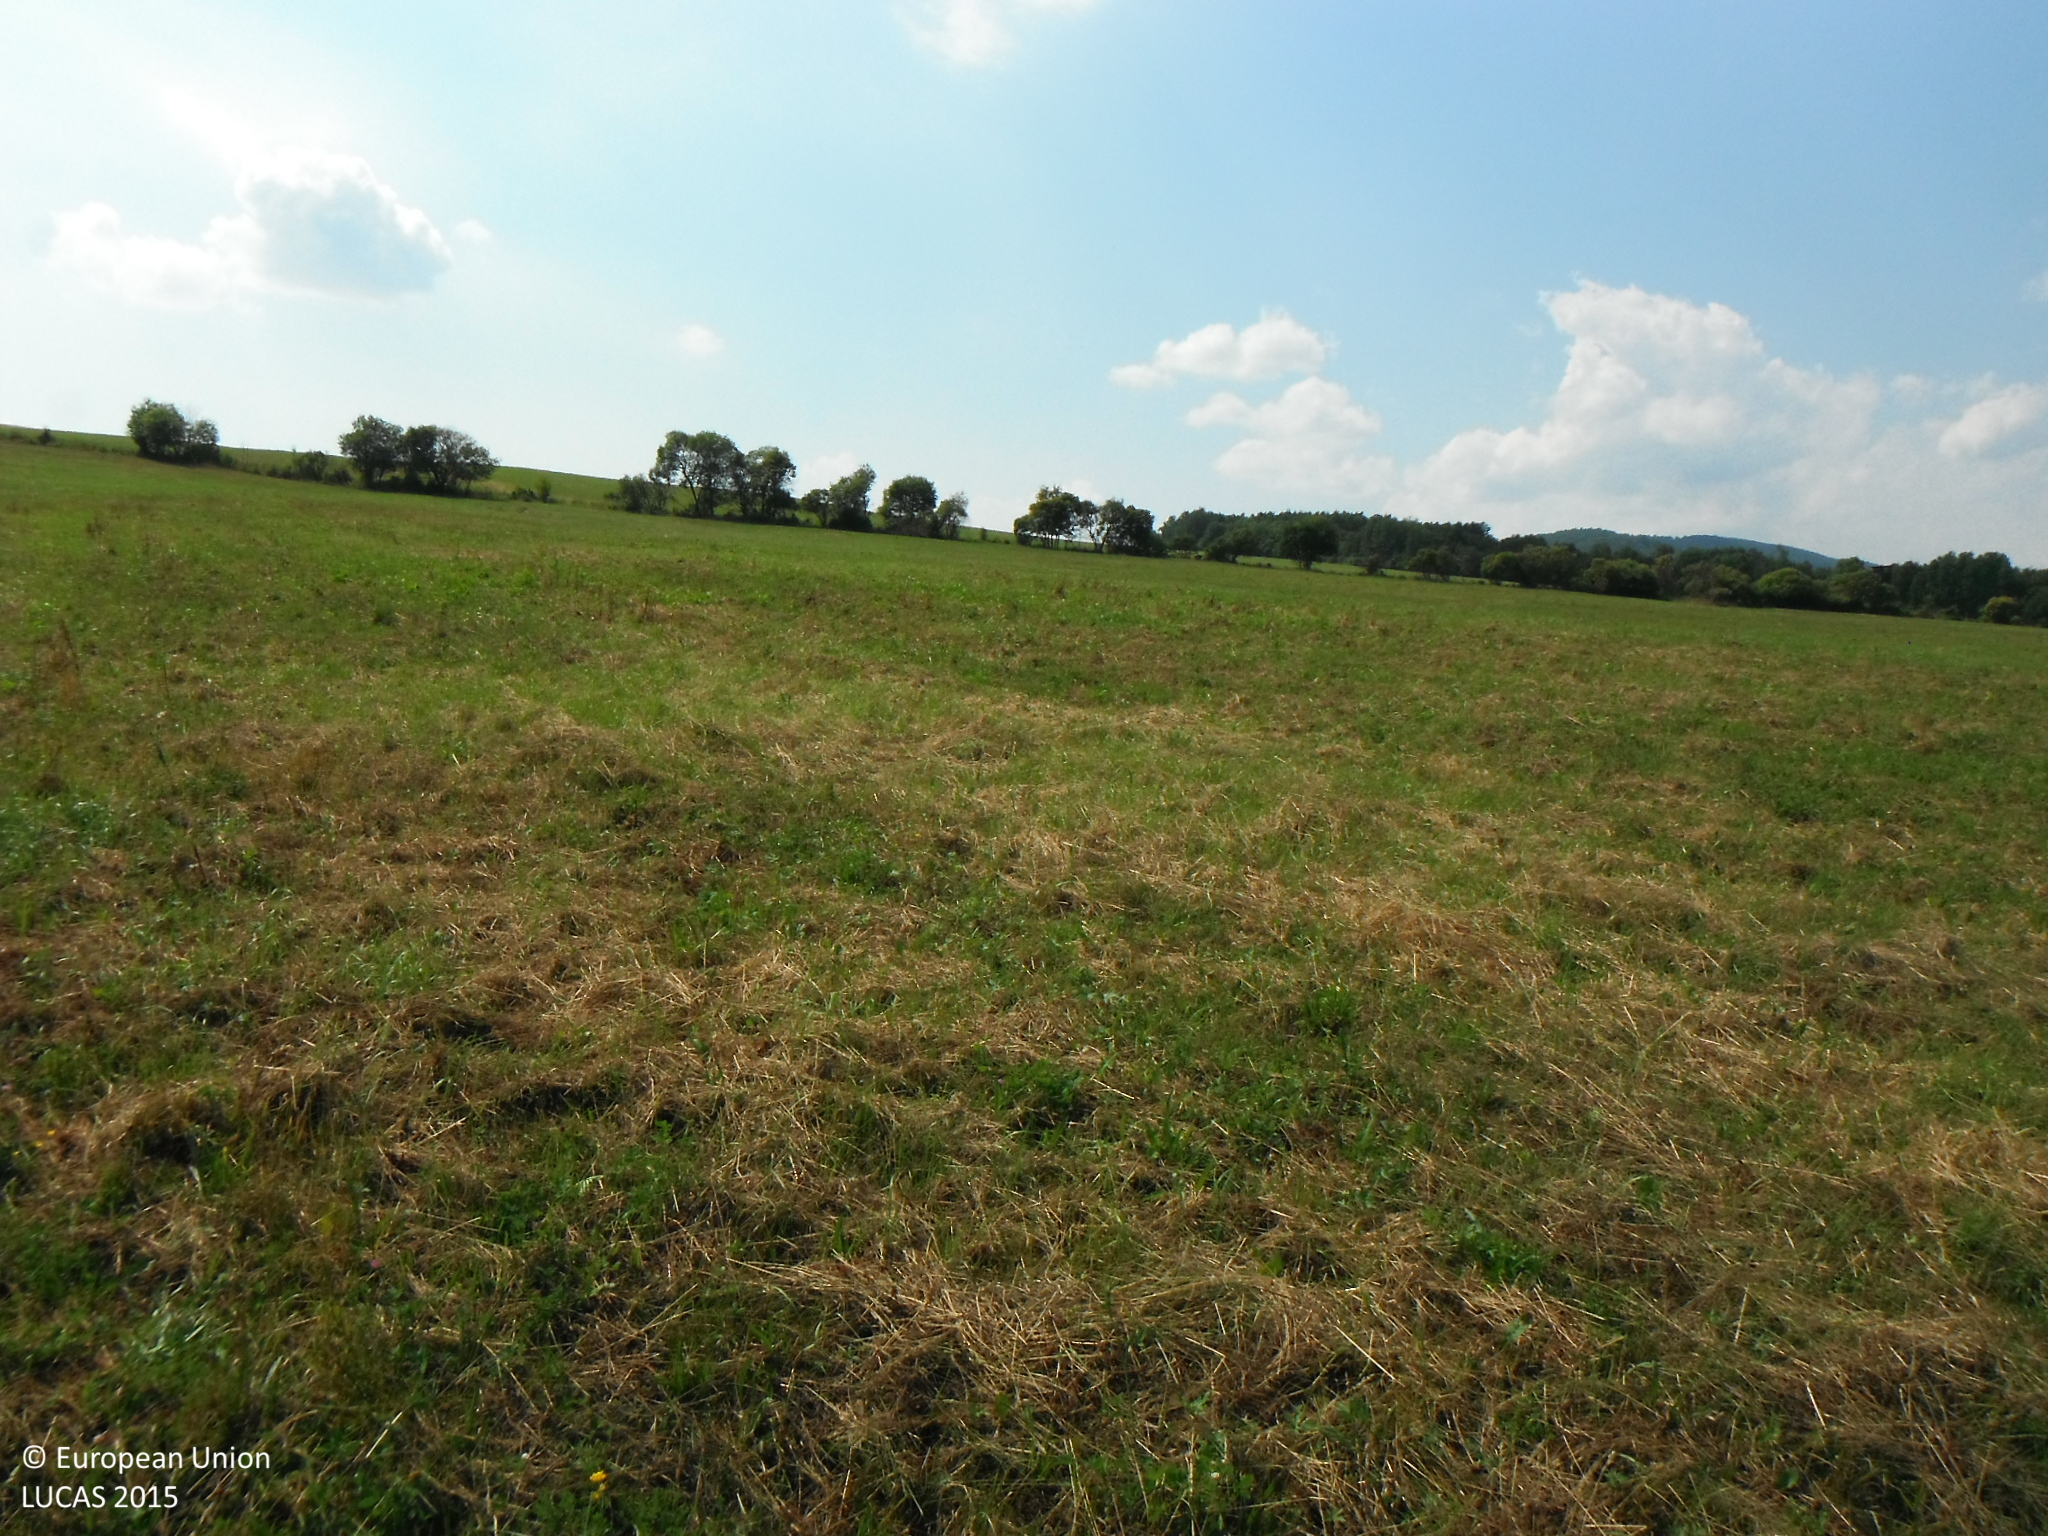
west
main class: Grassland
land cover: Grassland without tree/shrub cover
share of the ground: > 75 %
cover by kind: herbaceous plants 100 %
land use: Agriculture (excluding fallow land and kitchen gardens)
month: July
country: SK
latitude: 49.3676
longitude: 21.4647
